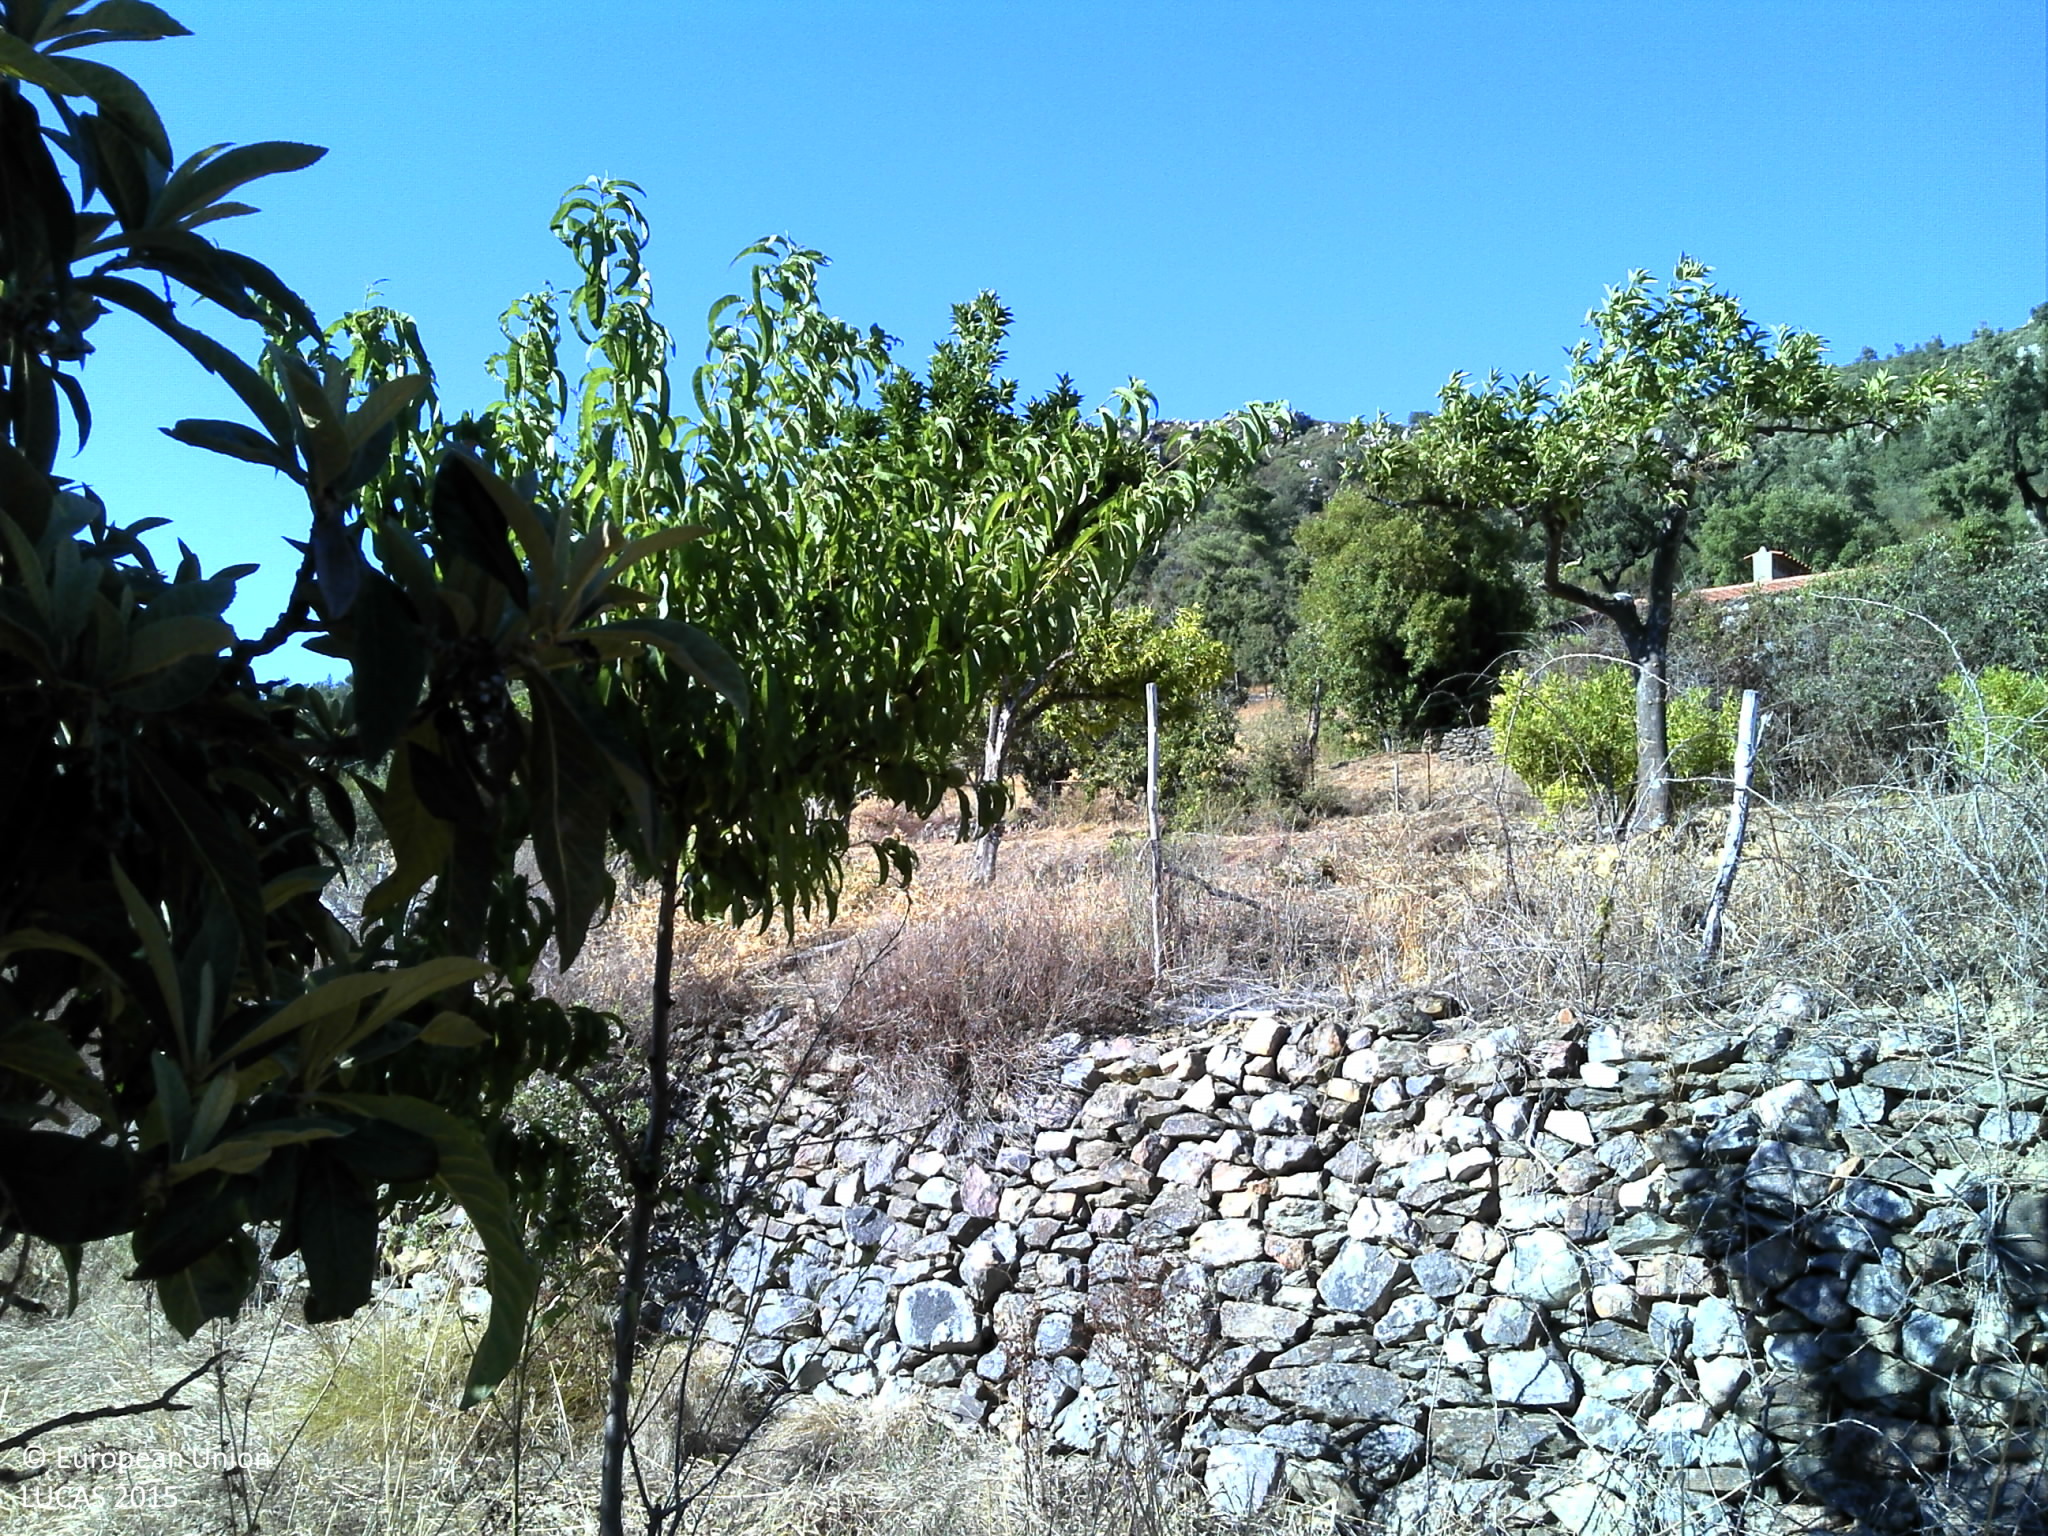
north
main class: Cropland
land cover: Other fruit trees and berries
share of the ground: 10 - 25 %
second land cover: Grassland without tree/shrub cover
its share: 10 - 25 %
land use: Agriculture (excluding fallow land and kitchen gardens)
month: August
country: PT
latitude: 39.5776
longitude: -7.6425
